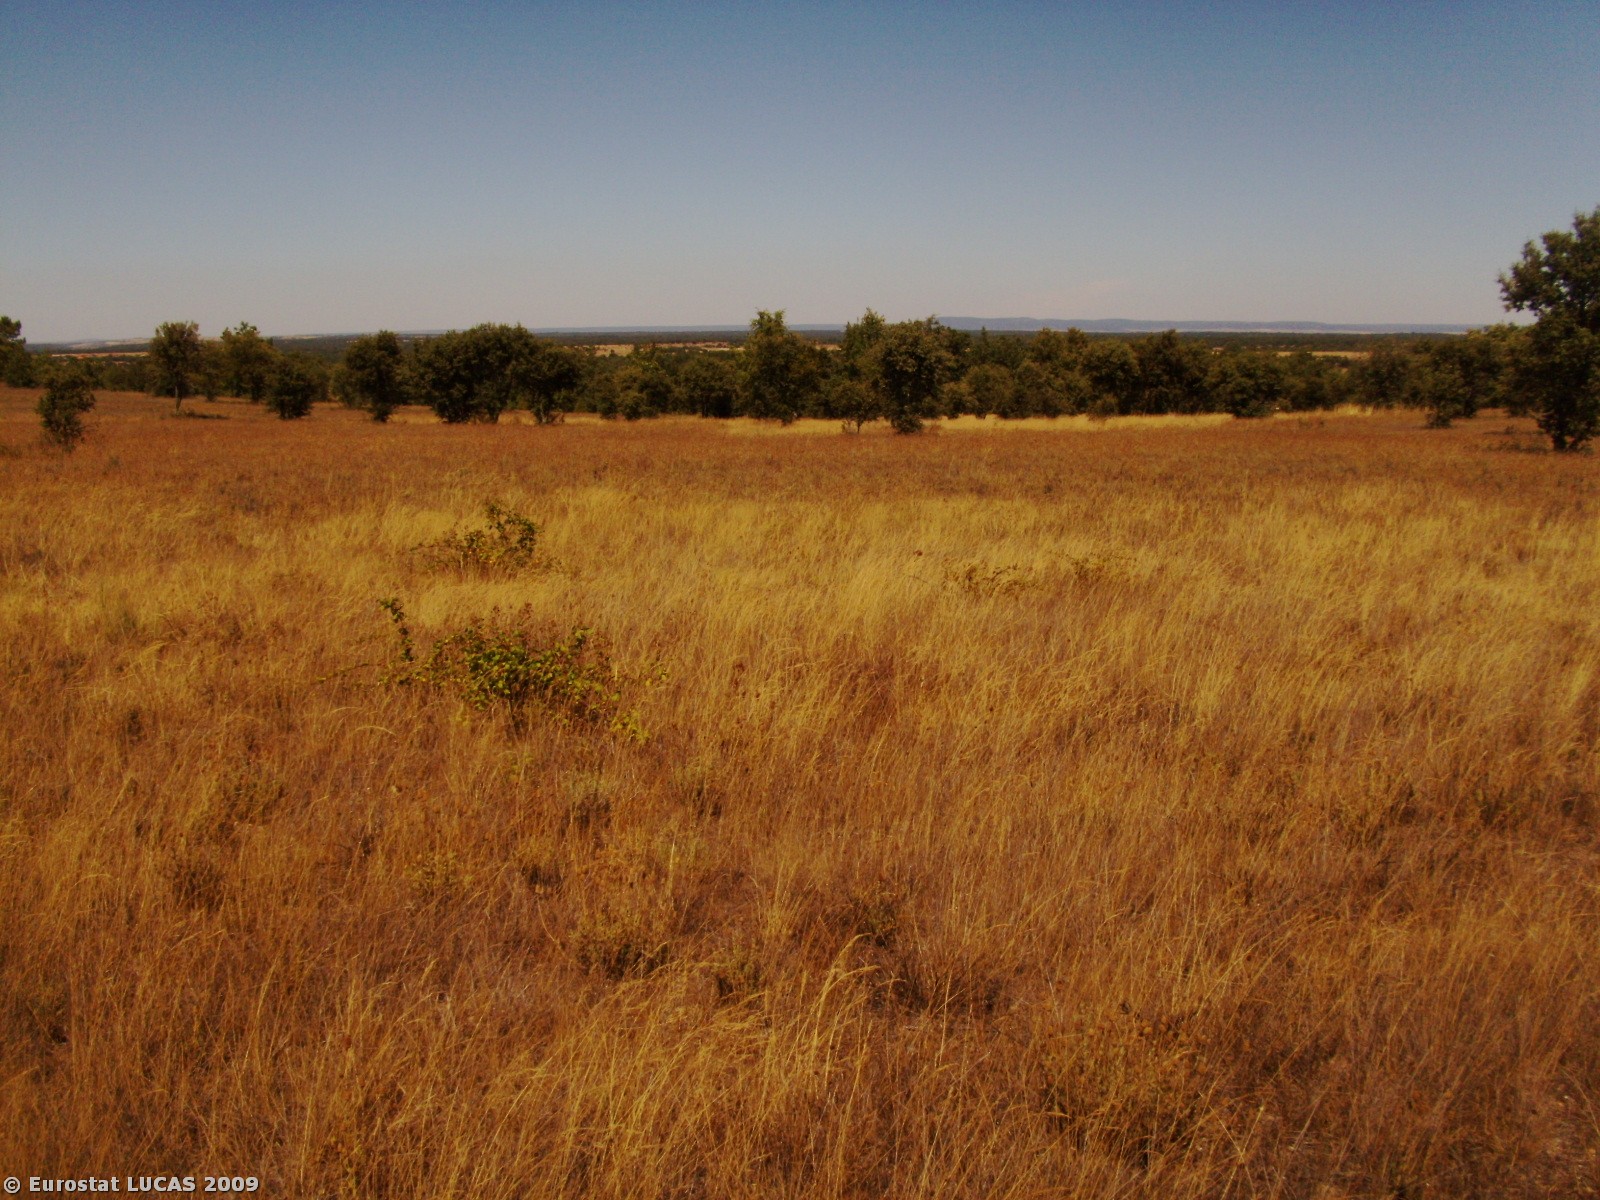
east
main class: Woodland
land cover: Broadleaved woodland
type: broadleaved evergreen forest
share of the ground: 25 - 50 %
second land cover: Spontaneously vegetated surfaces
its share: 50 - 75 %
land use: Forestry
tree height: > 5 m
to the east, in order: Broadleaved woodland; Spontaneously vegetated surfaces; Broadleaved woodland; Spontaneously vegetated surfaces; Fences; Broadleaved woodland; Spontaneously vegetated surfaces
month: July
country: PT
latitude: 40.5310
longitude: -6.8474
